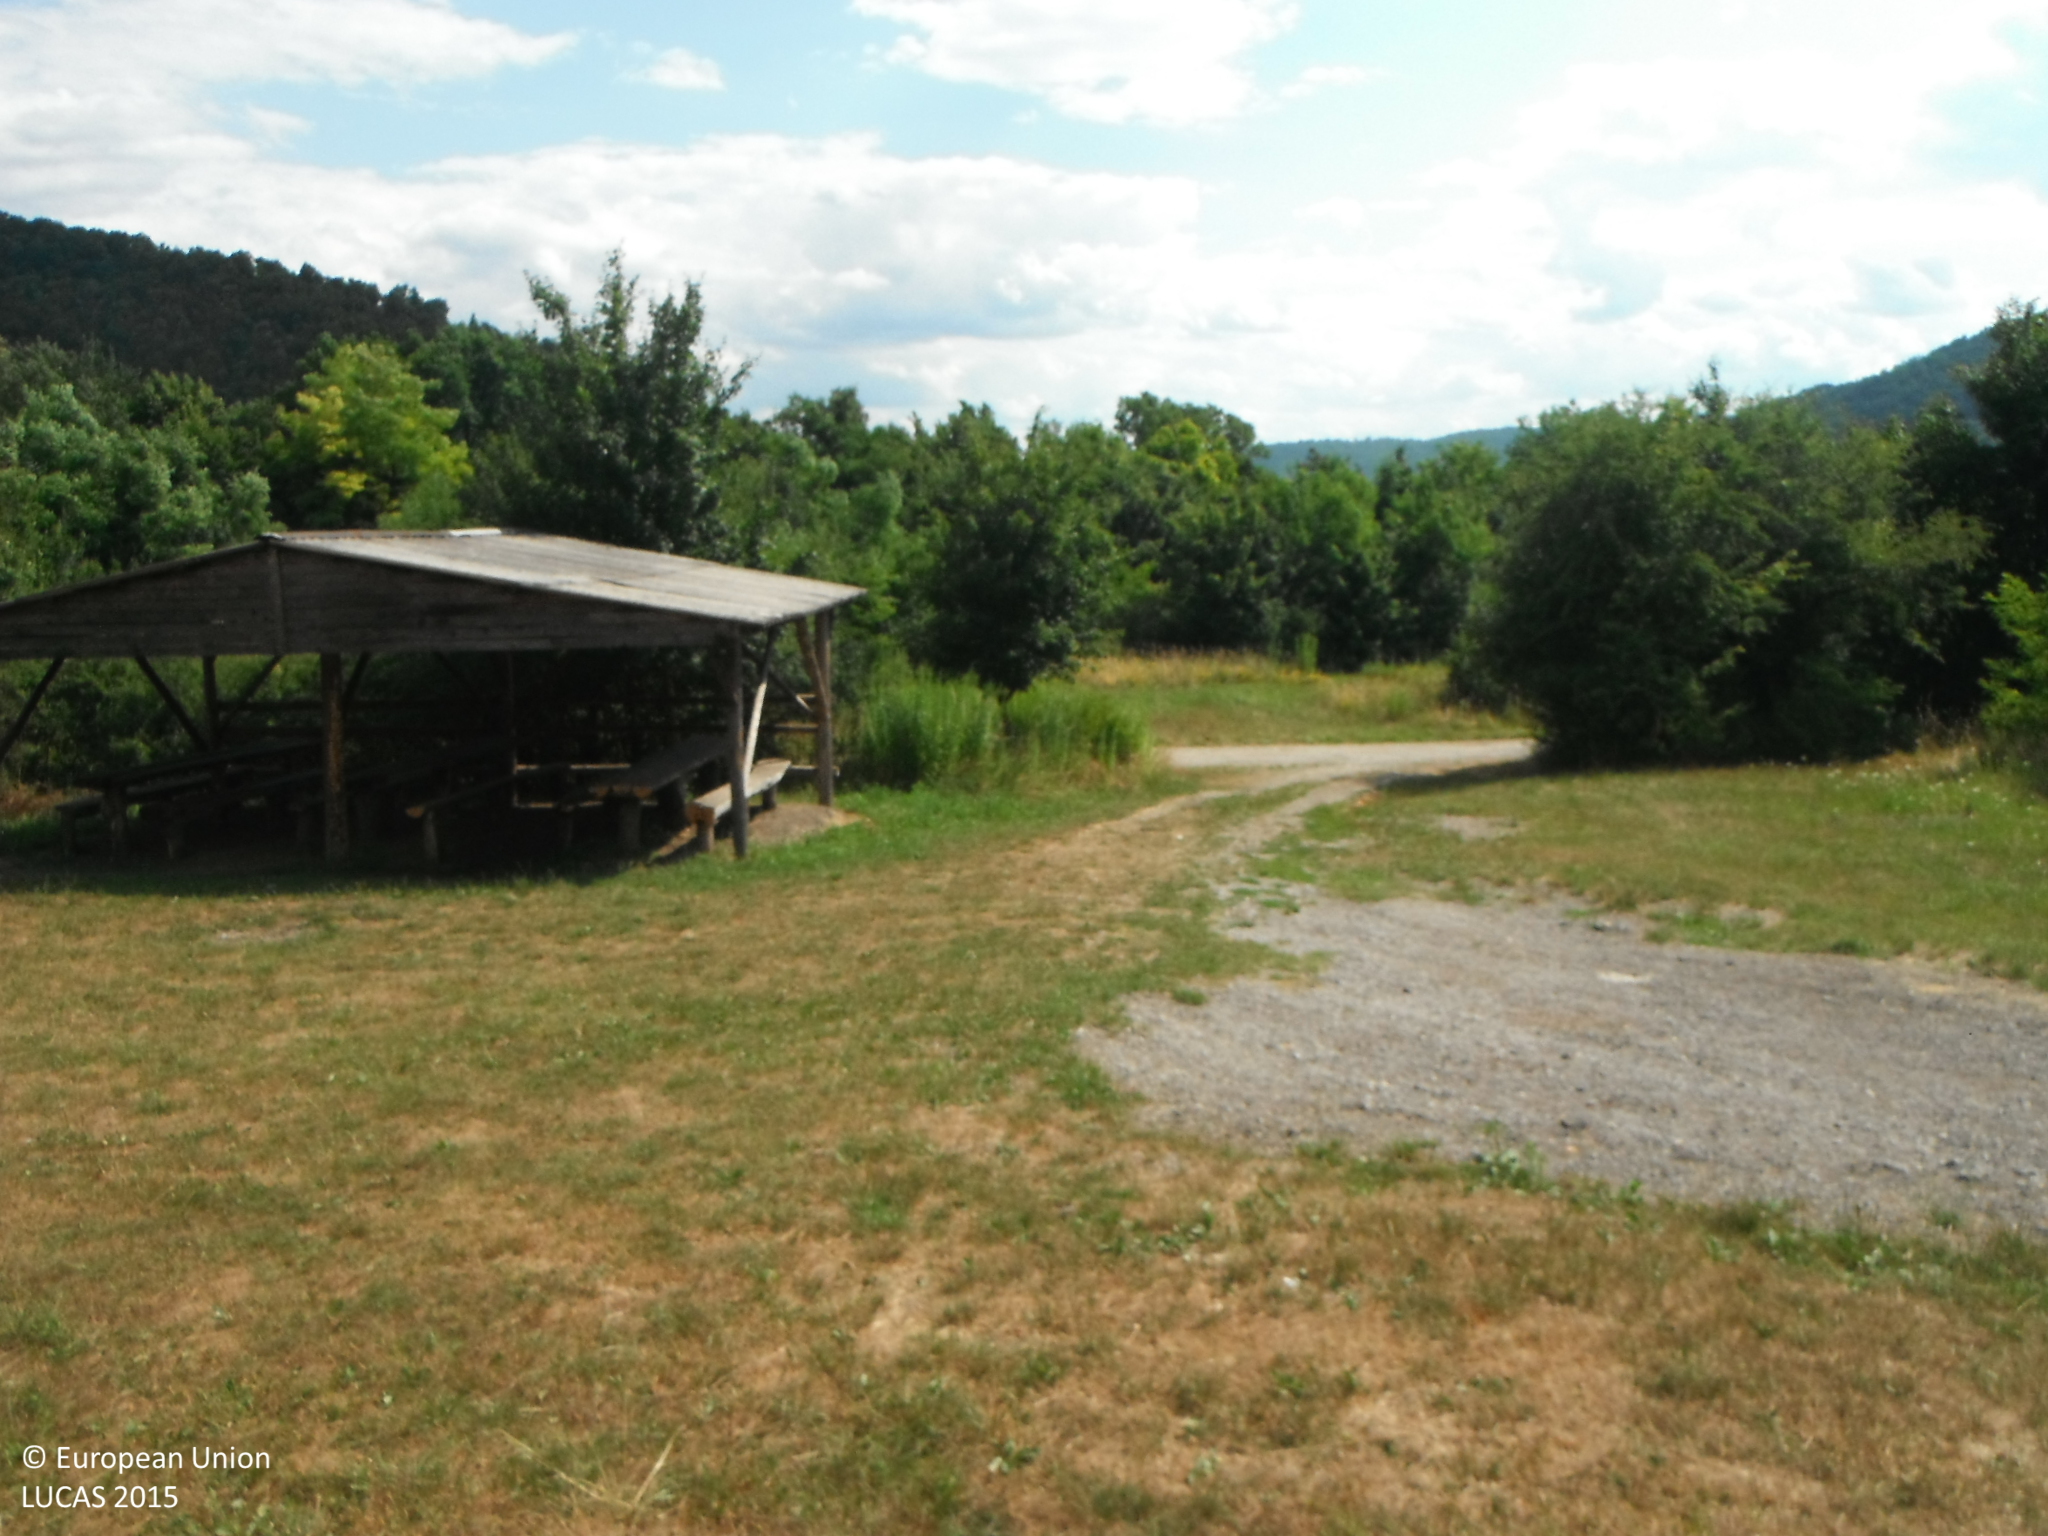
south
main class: Grassland
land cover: Grassland without tree/shrub cover
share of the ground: > 75 %
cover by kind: herbaceous plants 100 %
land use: Amenities, museums, leisure
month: July
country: SK
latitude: 48.6332
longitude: 20.2502
